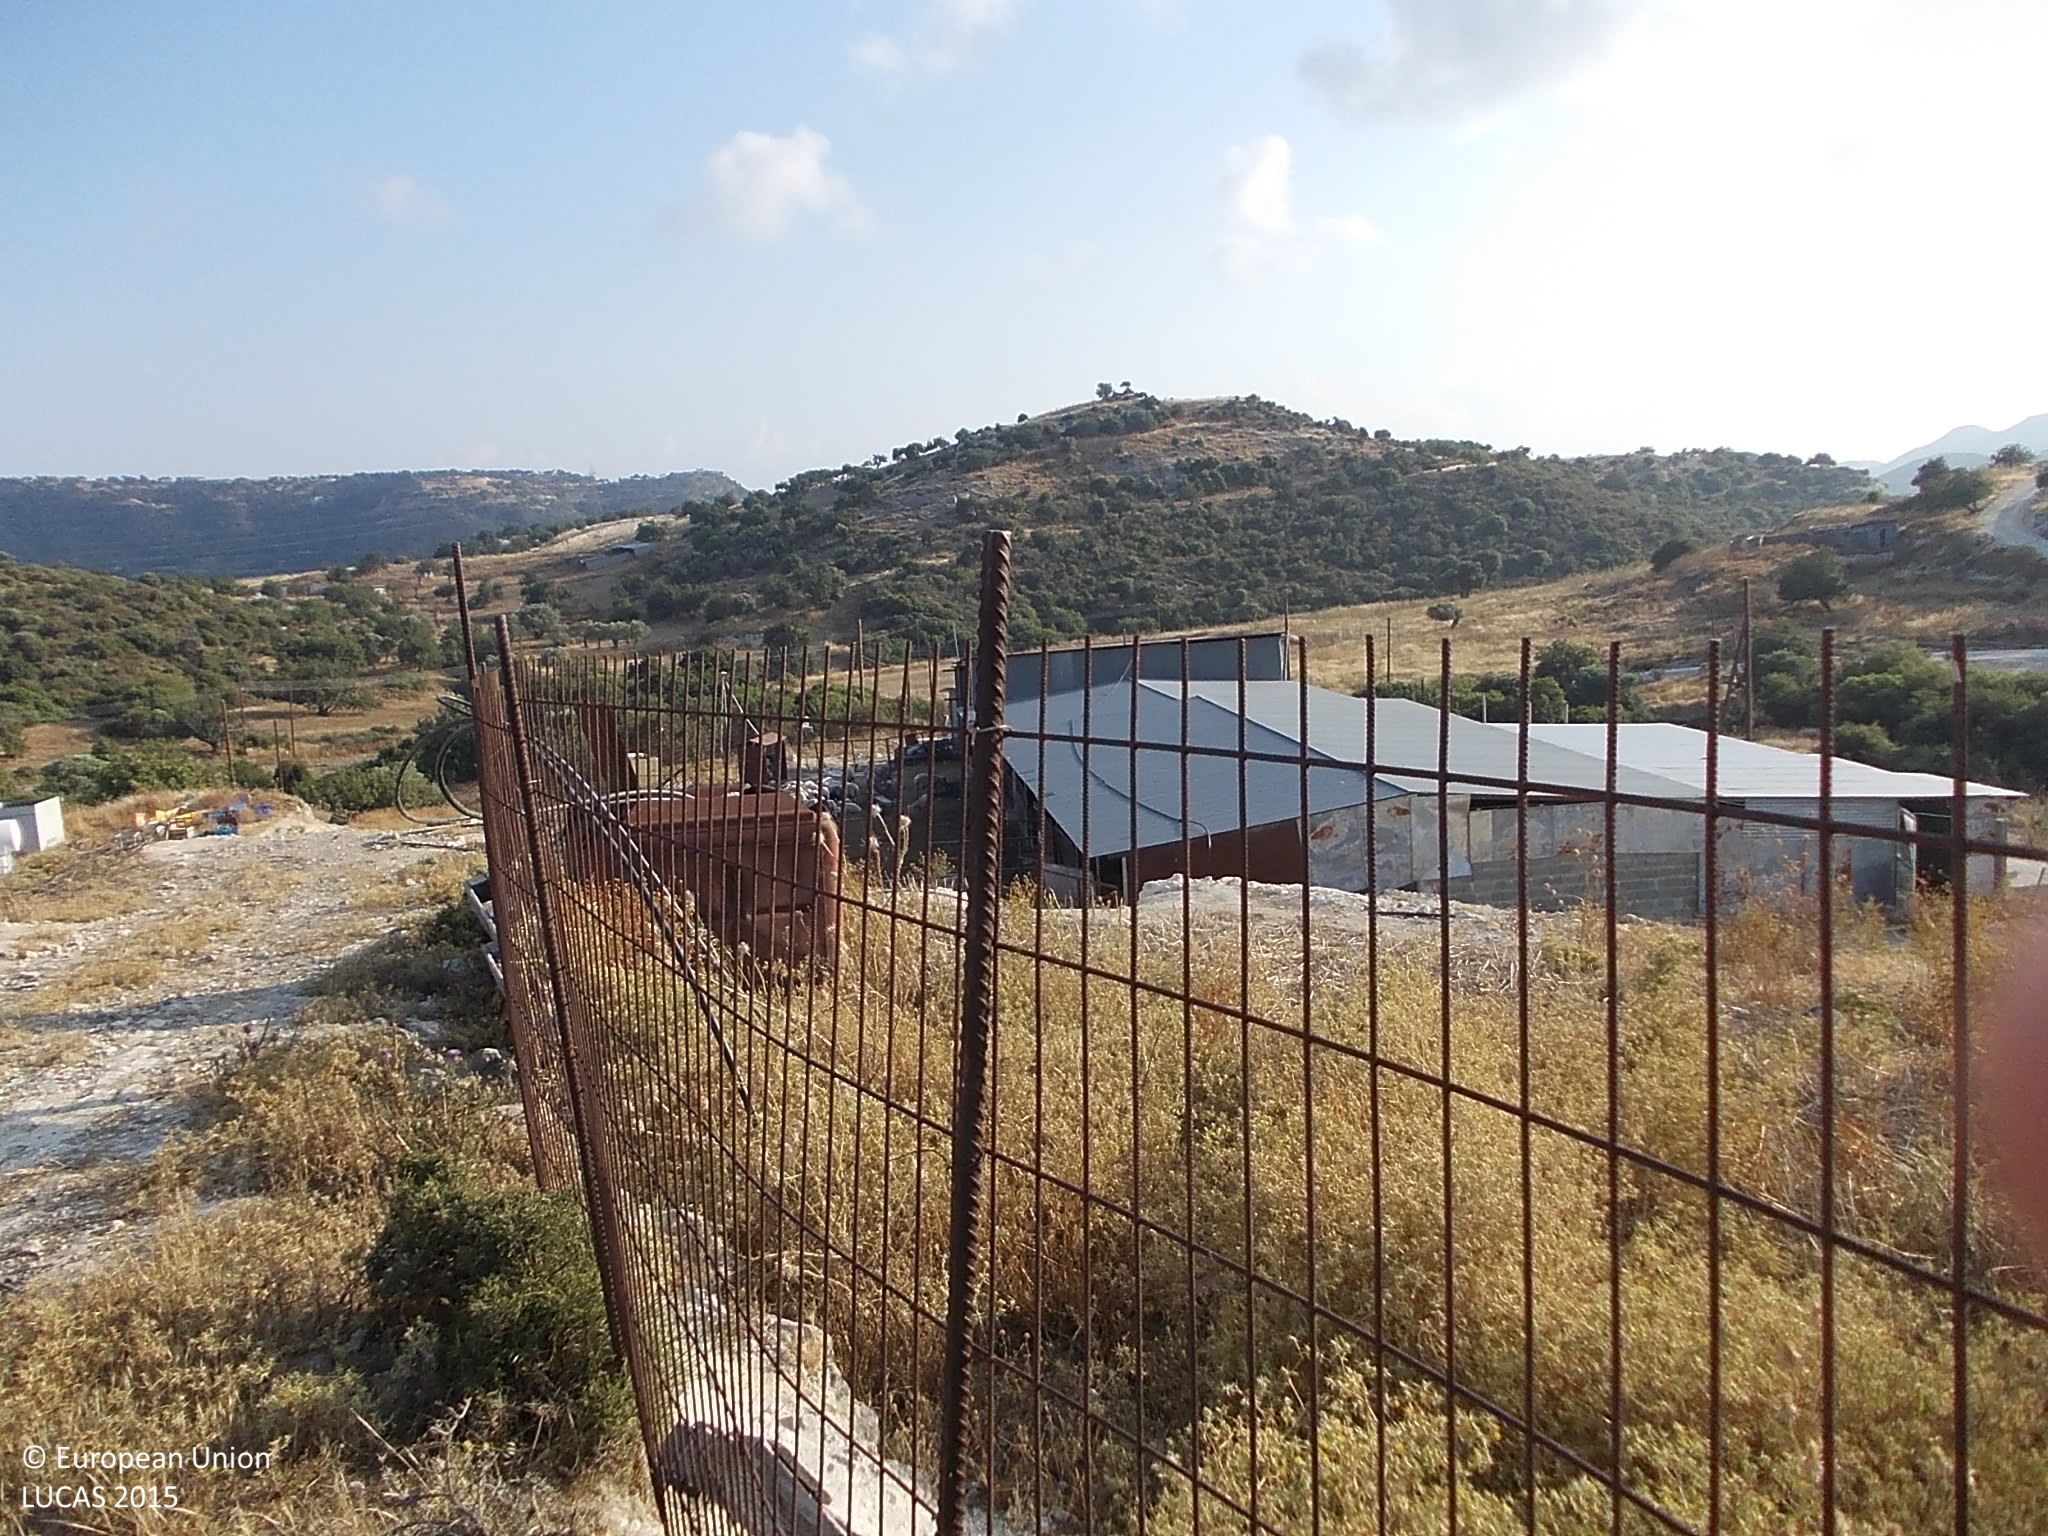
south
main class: Grassland
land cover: Grassland without tree/shrub cover
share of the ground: > 75 %
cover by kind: herbaceous plants 85 %, unconsolidated bare surface 15 %
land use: Logistics and storage
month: June
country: CY
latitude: 34.6850
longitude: 32.6912
